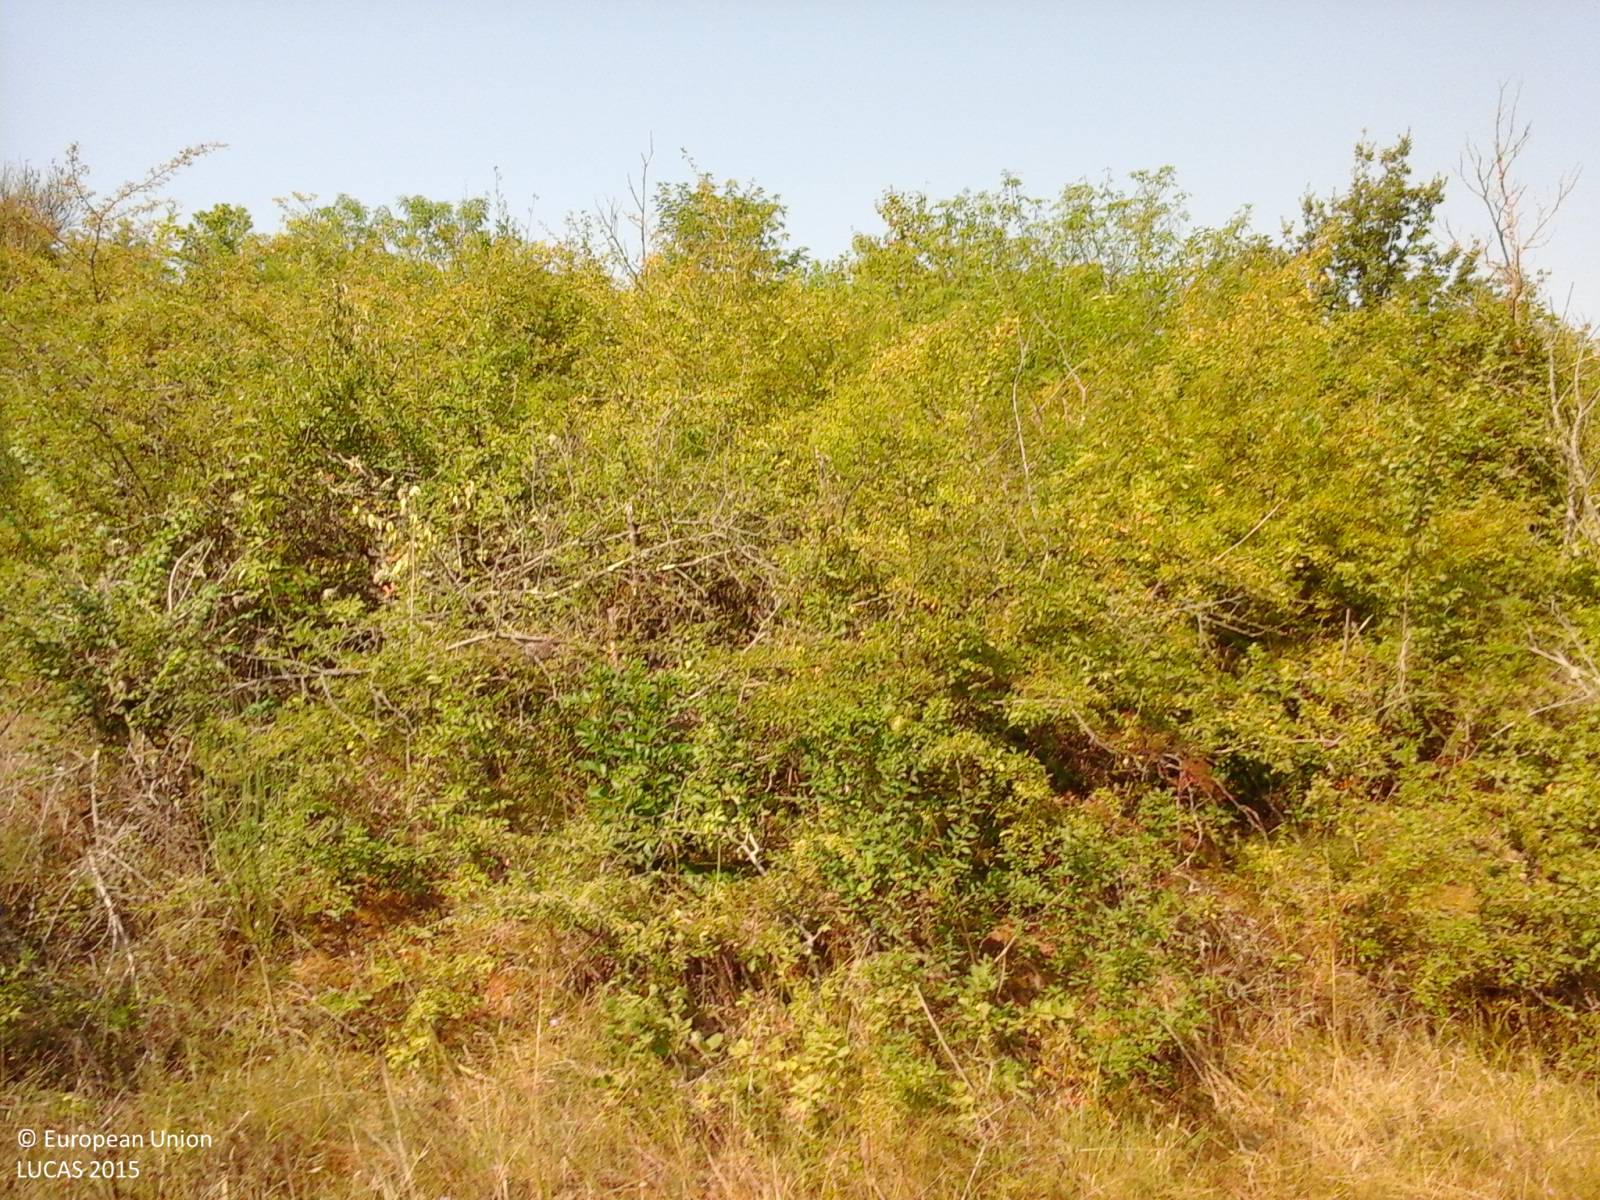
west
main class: Woodland
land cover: Broadleaved woodland
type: thermophilous deciduous forest
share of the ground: > 75 %
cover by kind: broadleaved forest trees 75 %, shrubs 25 %
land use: Forestry
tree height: < 5 m
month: August
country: IT
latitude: 42.1988
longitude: 12.0877
